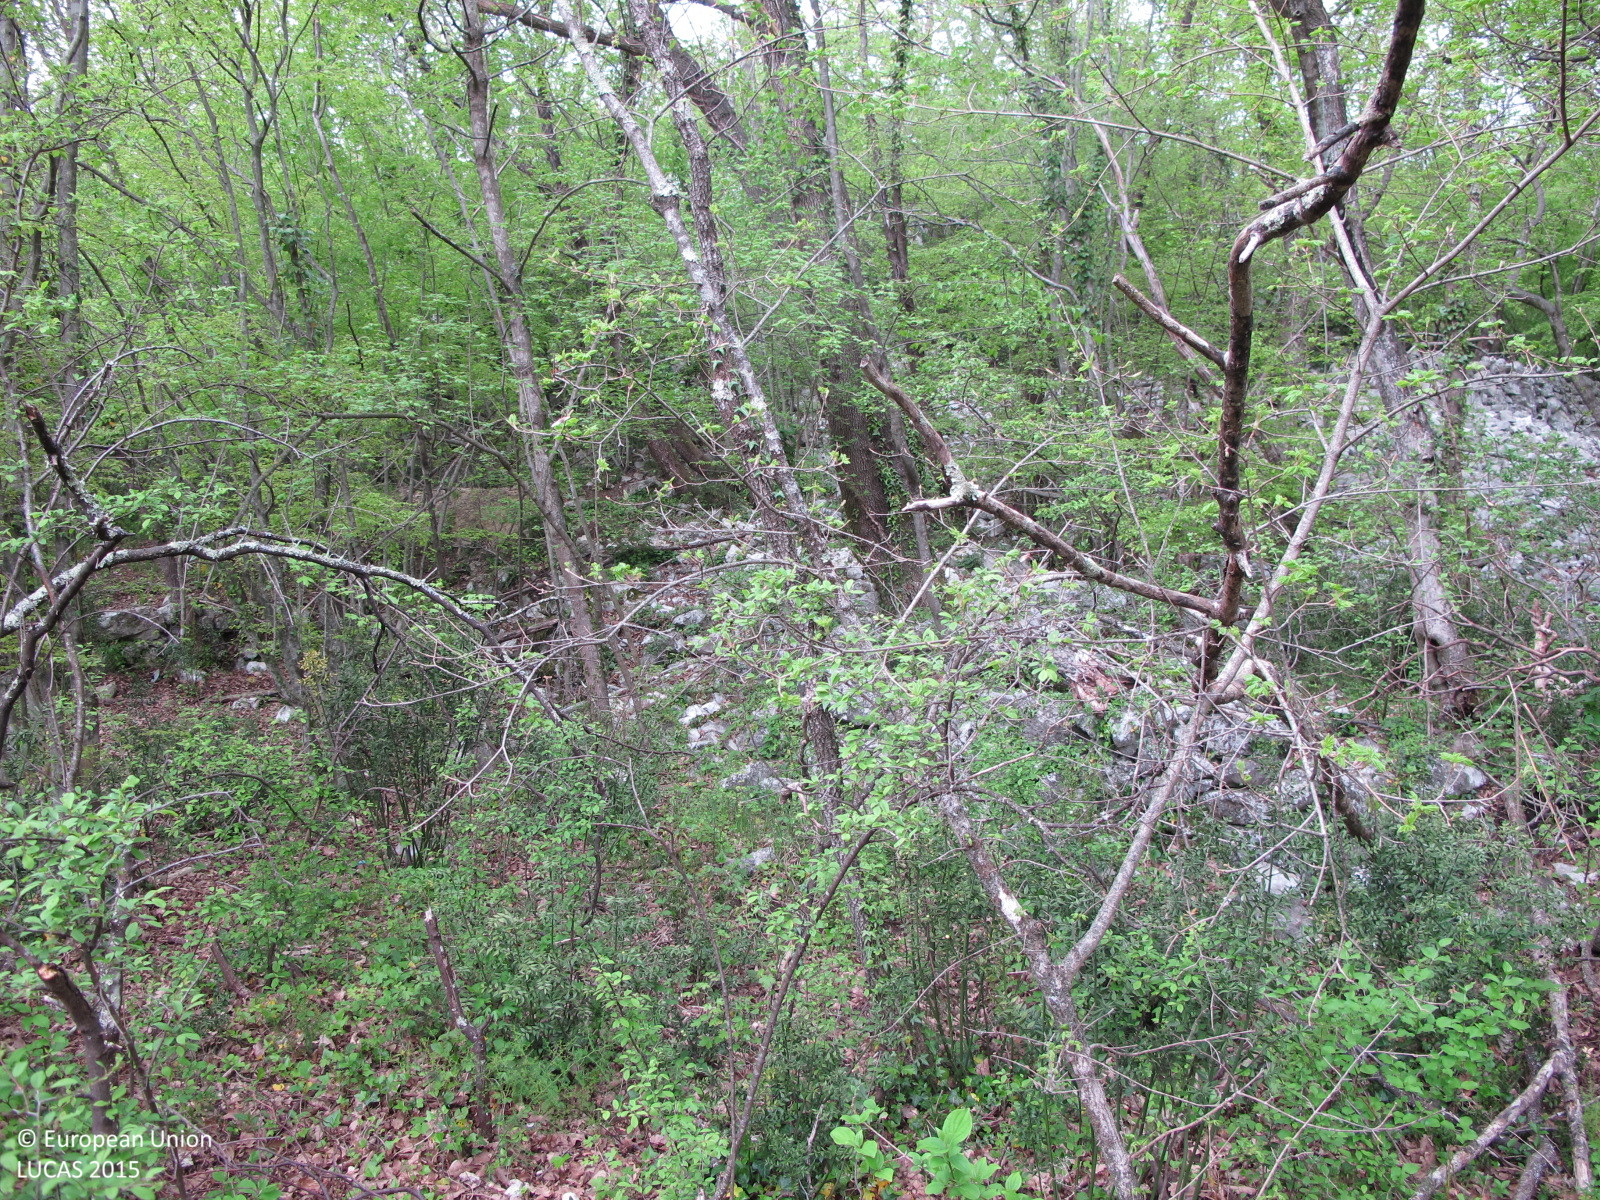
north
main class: Woodland
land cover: Broadleaved woodland
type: thermophilous deciduous forest
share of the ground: > 75 %
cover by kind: broadleaved forest trees 70 %, shrubs 15 %, herbaceous plants 5 %
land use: Semi-natural and natural areas not in use
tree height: > 5 m
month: April
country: HR
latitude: 45.2229
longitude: 14.6177
